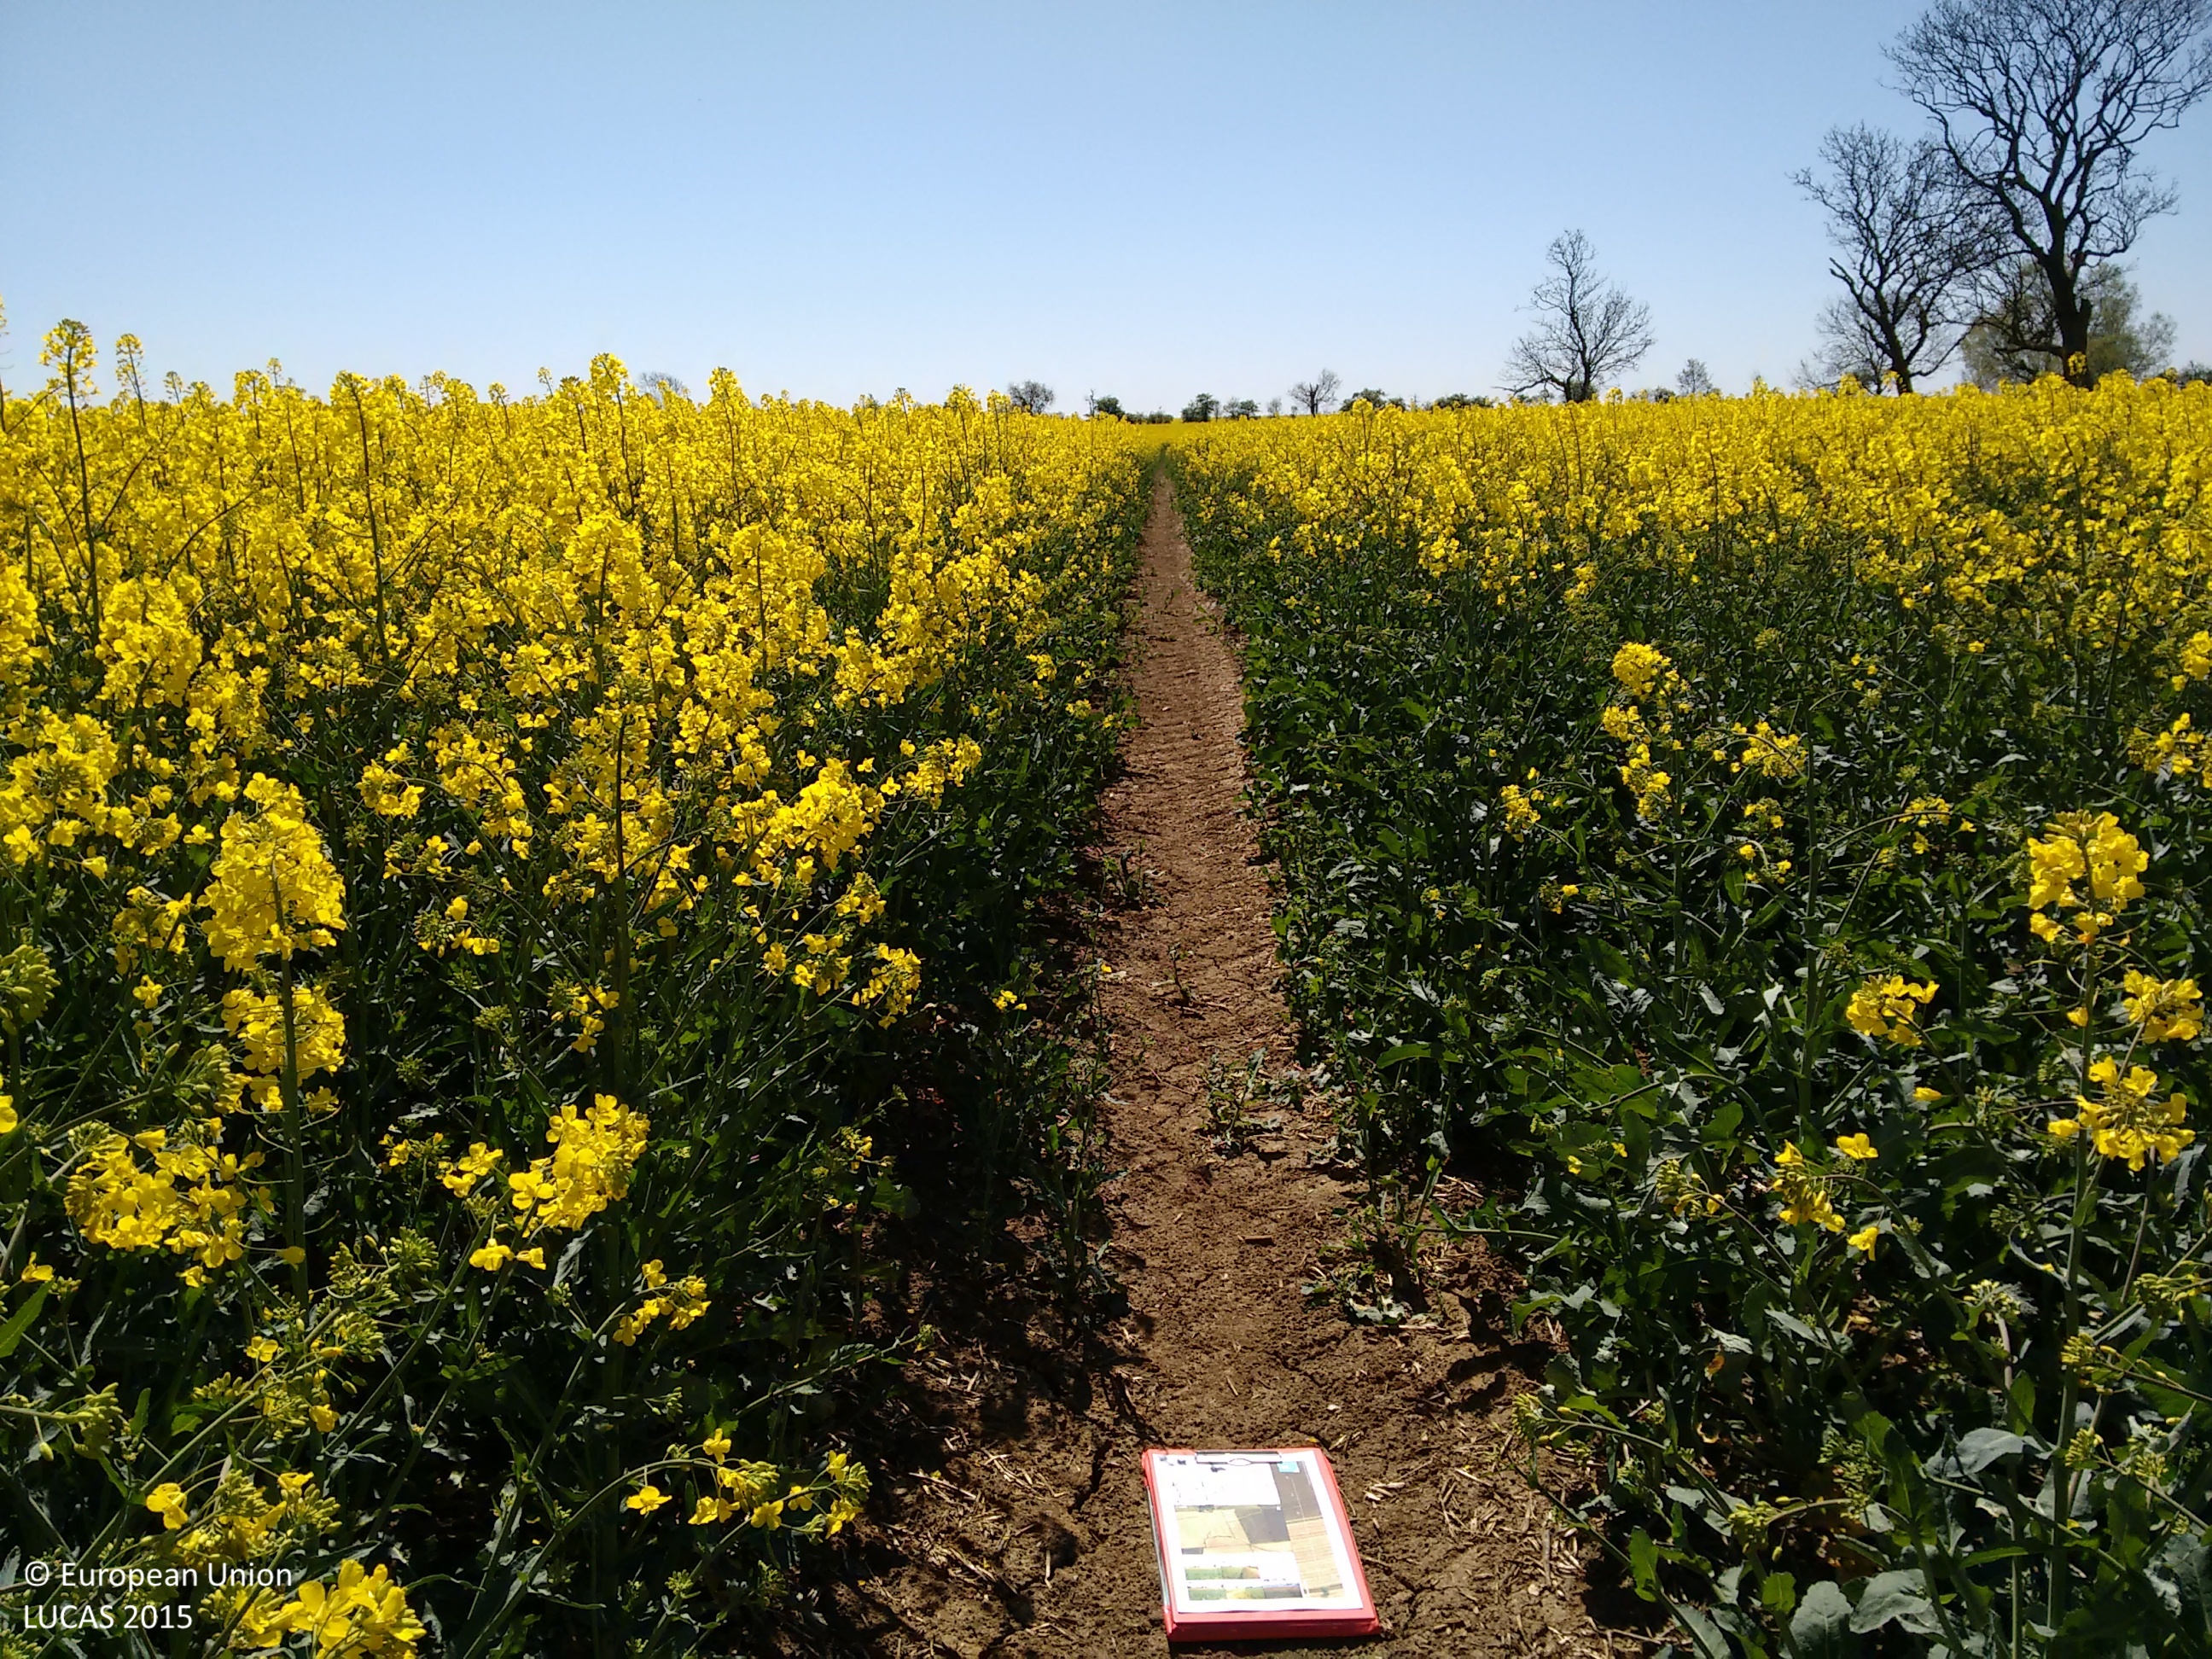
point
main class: Cropland
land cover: Rape and turnip rape
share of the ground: > 75 %
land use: Agriculture (excluding fallow land and kitchen gardens)
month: April
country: GB
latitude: 53.3525
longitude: -0.6000
